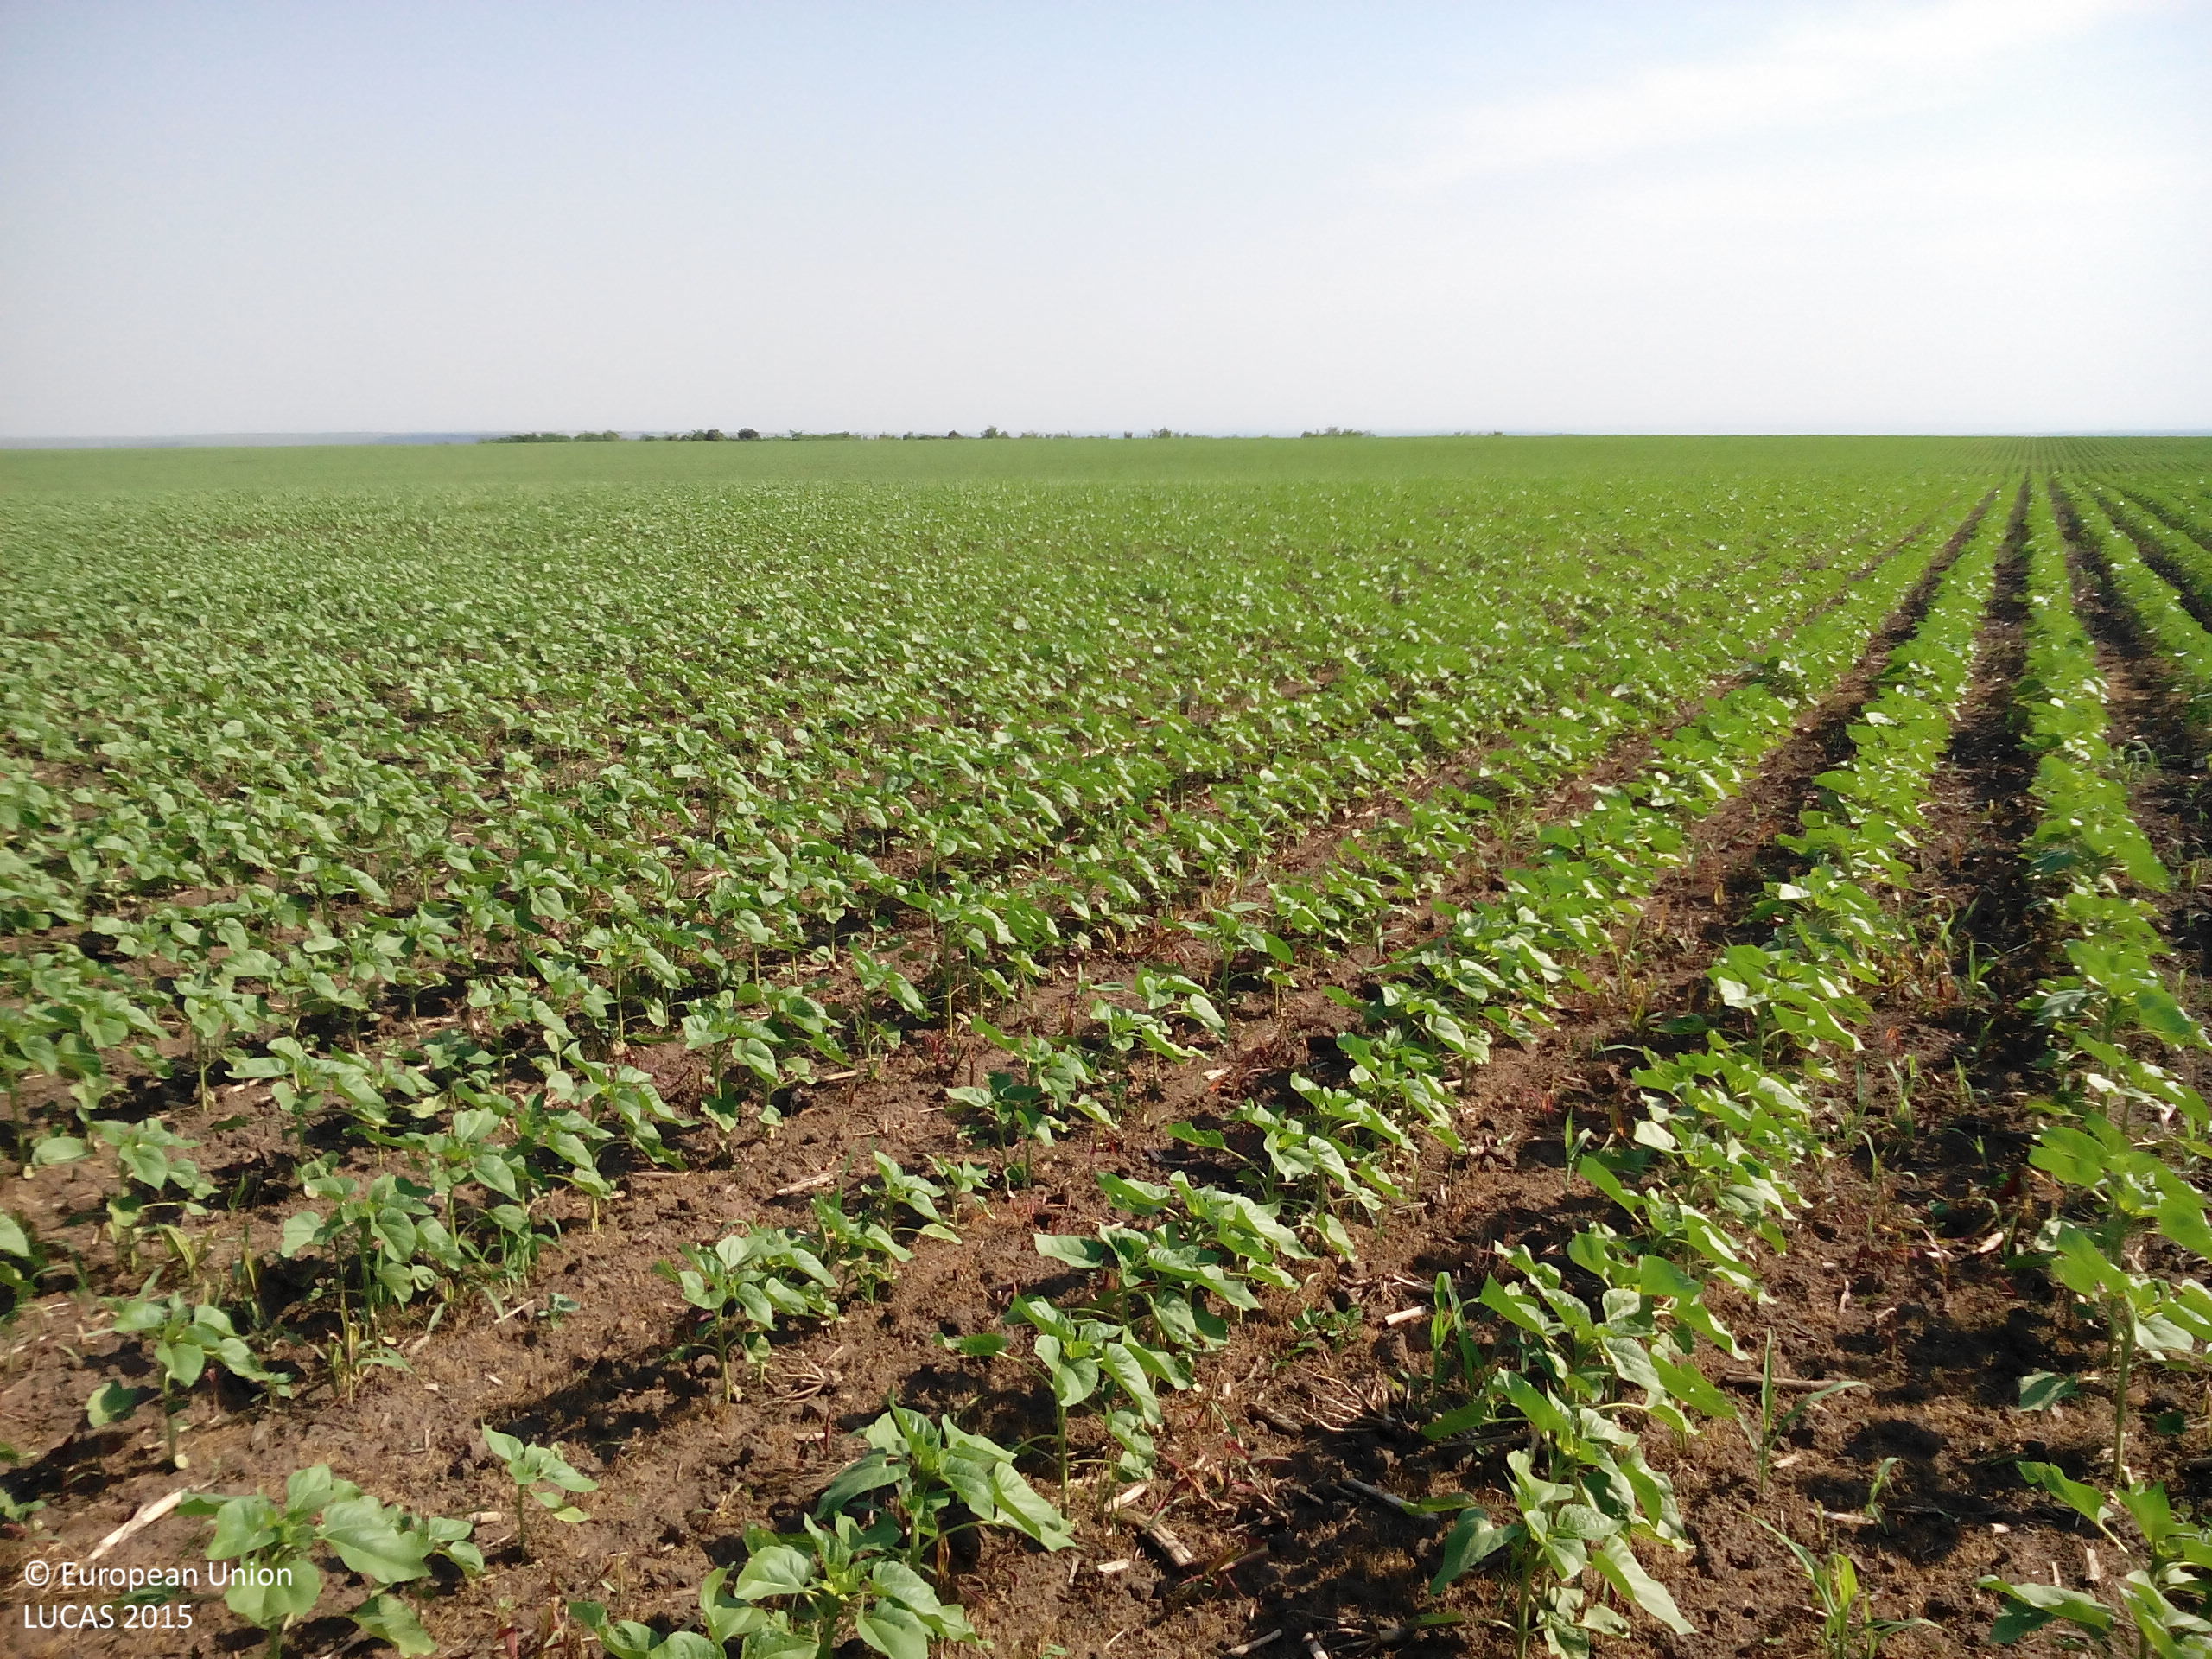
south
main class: Cropland
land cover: Sunflower
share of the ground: 50 - 75 %
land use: Agriculture (excluding fallow land and kitchen gardens)
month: May
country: BG
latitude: 43.6498
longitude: 24.2798
